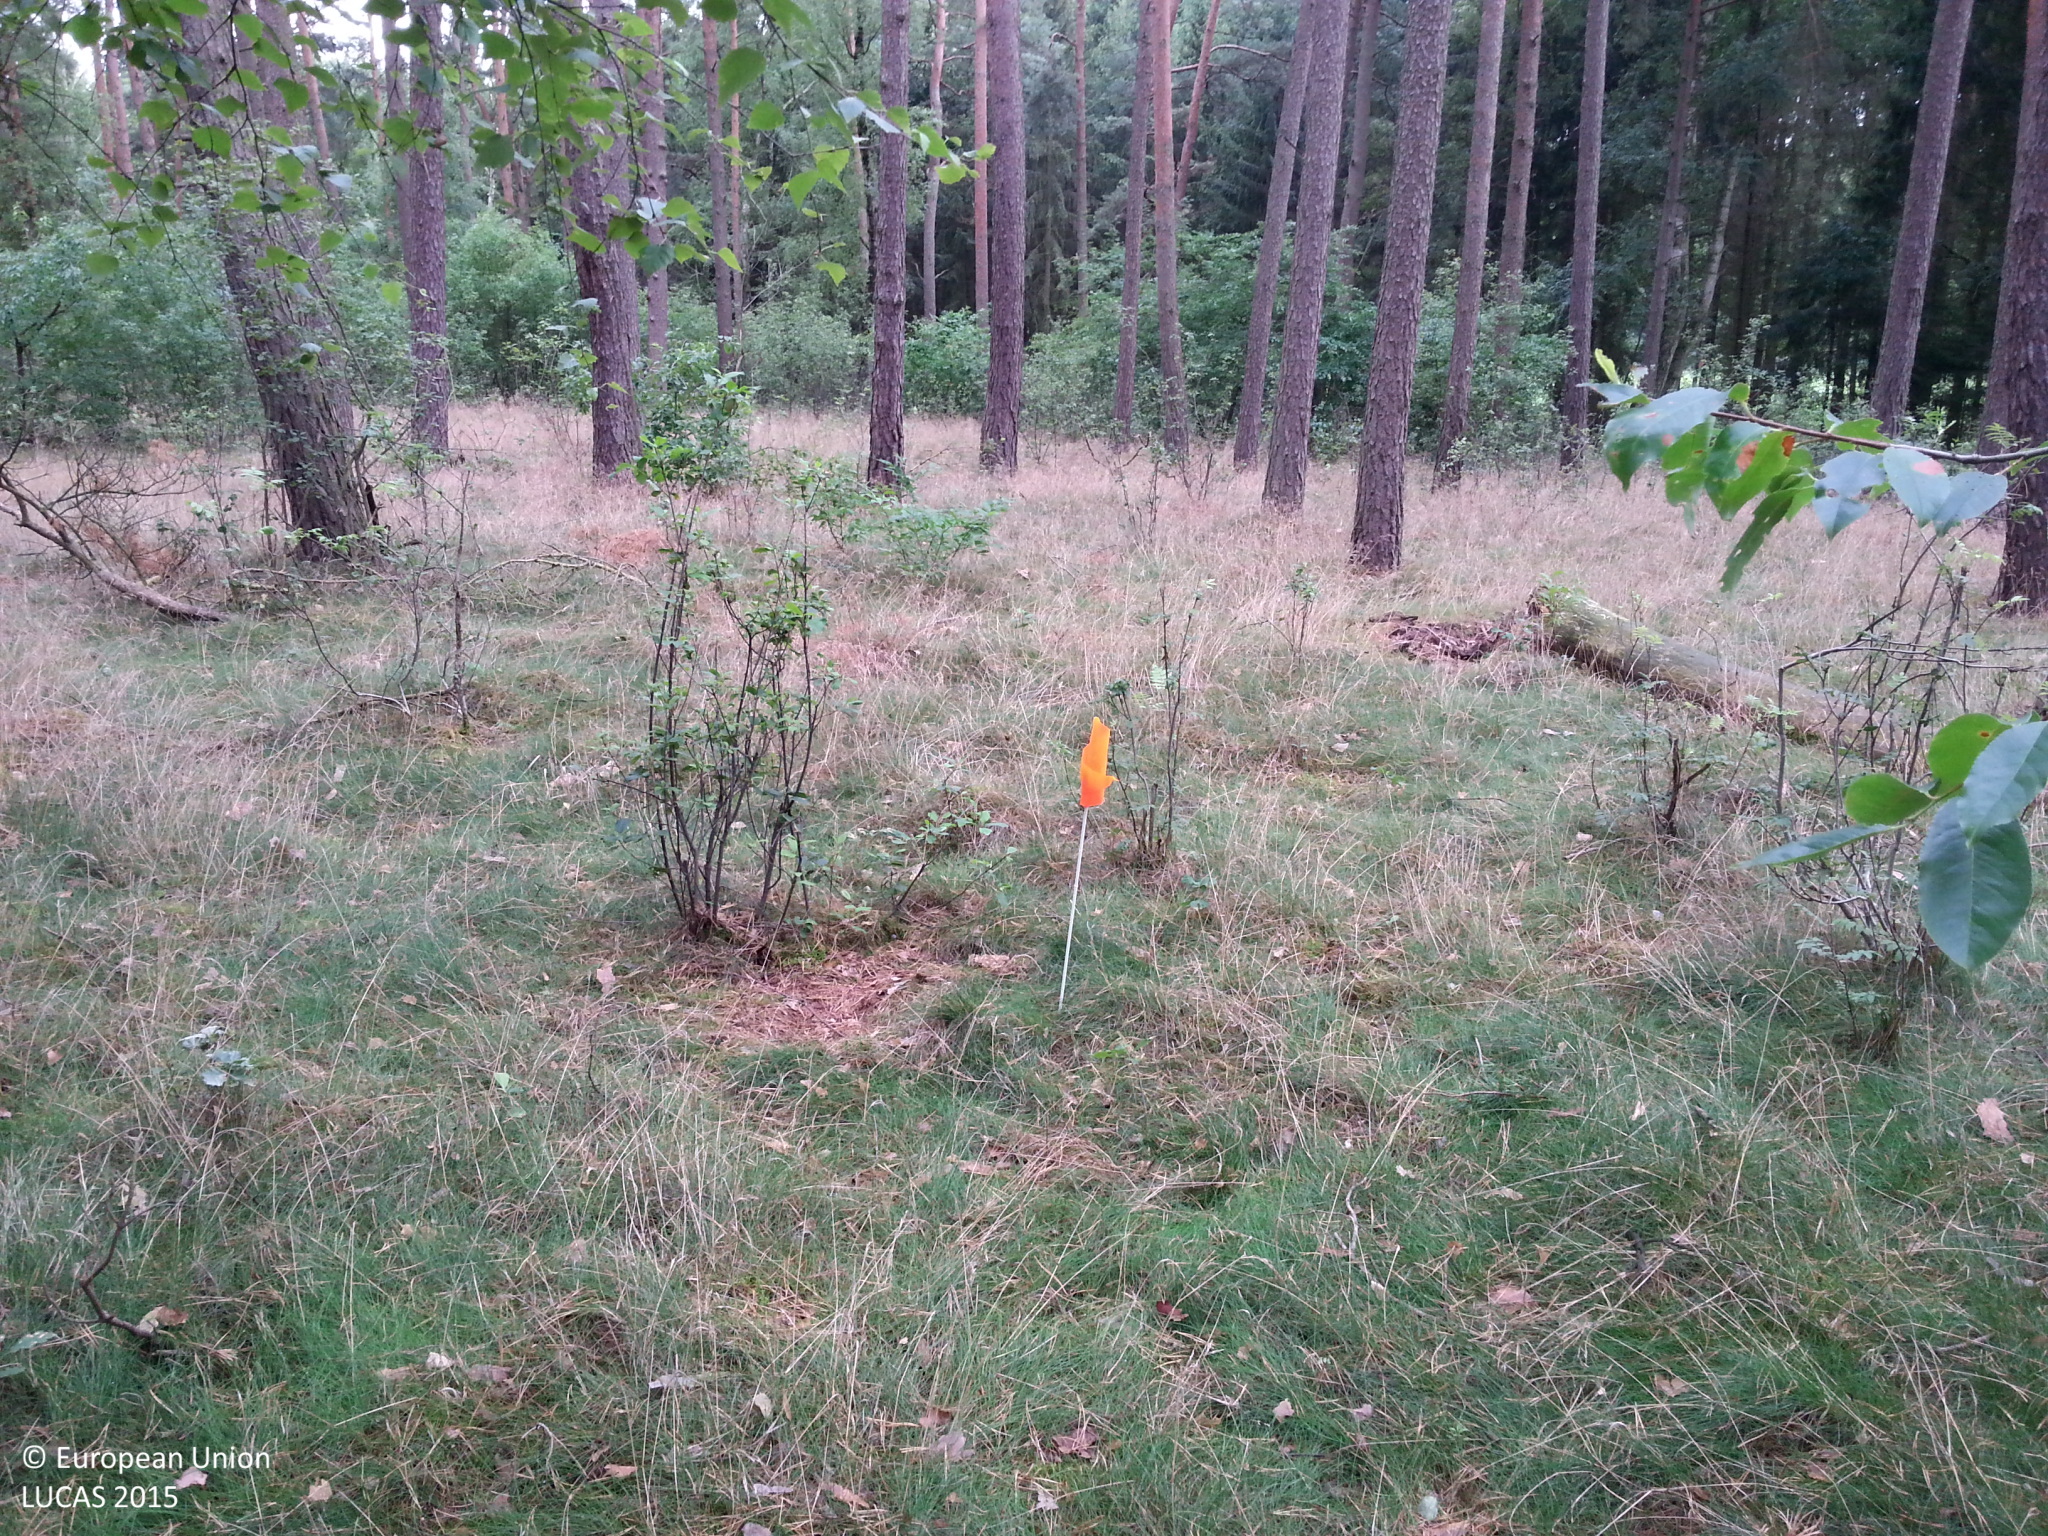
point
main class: Woodland
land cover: Pine dominated coniferous woodland
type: boreal forest
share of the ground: 50 - 75 %
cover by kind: coniferous forest trees 50 %, herbaceous plants 30 %, shrubs 15 %, lichens and mosses 5 %
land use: Forestry
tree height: > 5 m
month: July
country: DE
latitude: 53.0377
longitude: 12.3409
